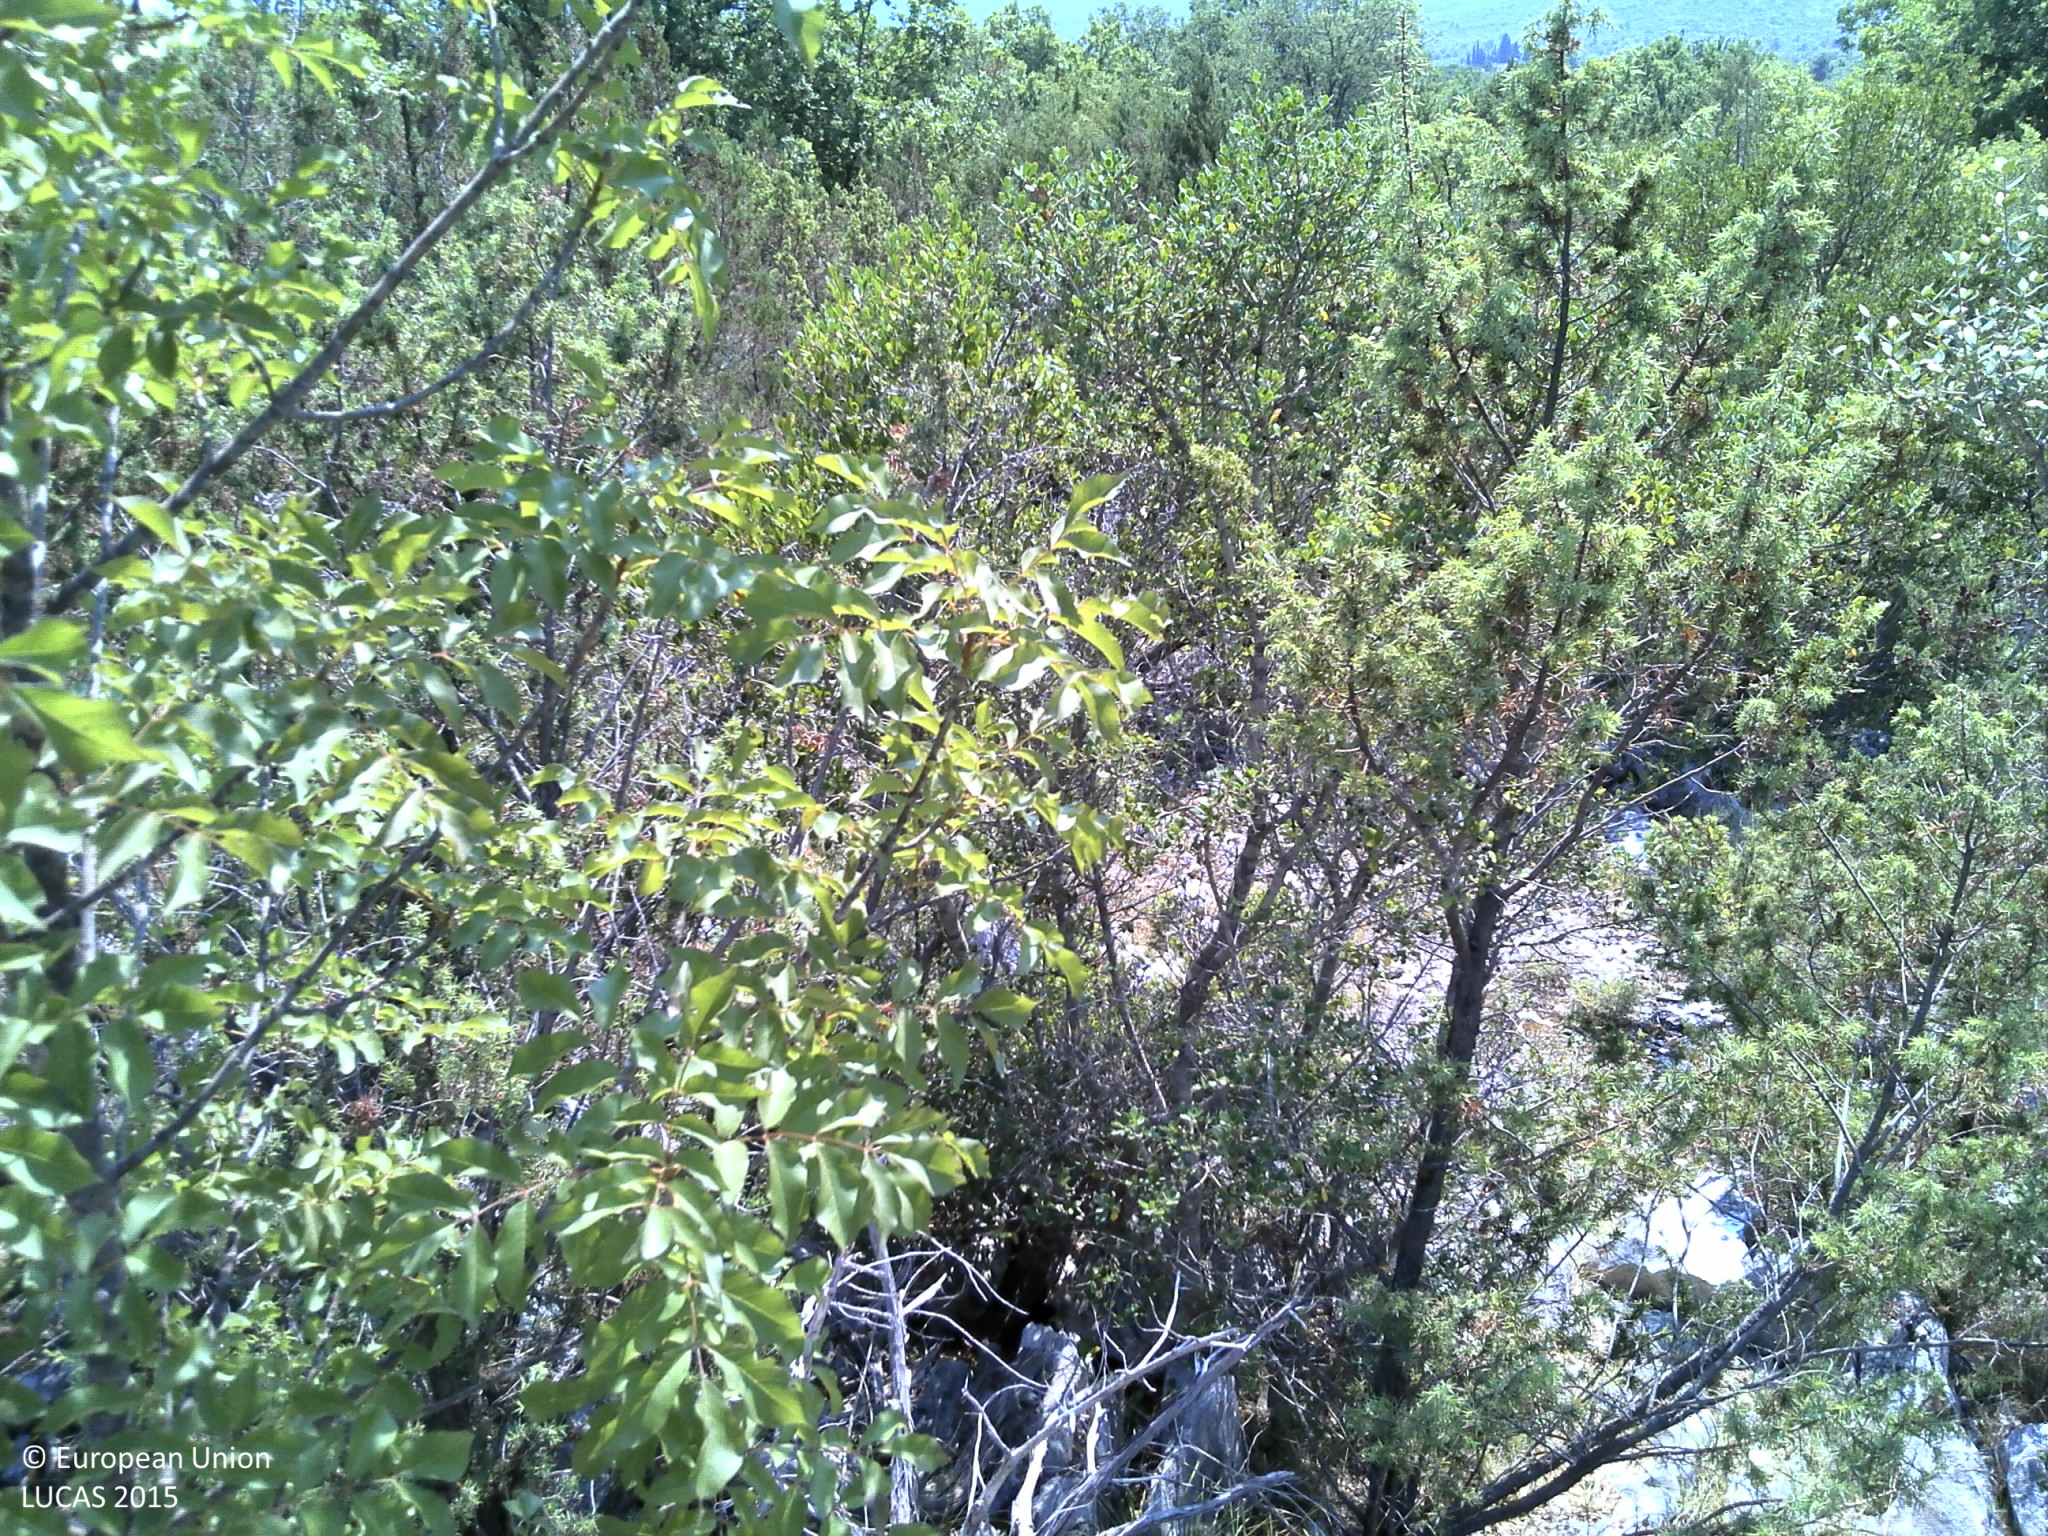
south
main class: Woodland
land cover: Broadleaved woodland
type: thermophilous deciduous forest
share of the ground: 25 - 50 %
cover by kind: broadleaved forest trees 35 %, shrubs 30 %, unconsolidated bare surface 20 %, consolidated bare surface 10 %, coniferous forest trees 5 %
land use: Semi-natural and natural areas not in use
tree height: > 5 m
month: July
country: HR
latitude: 42.9068
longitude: 17.6700
